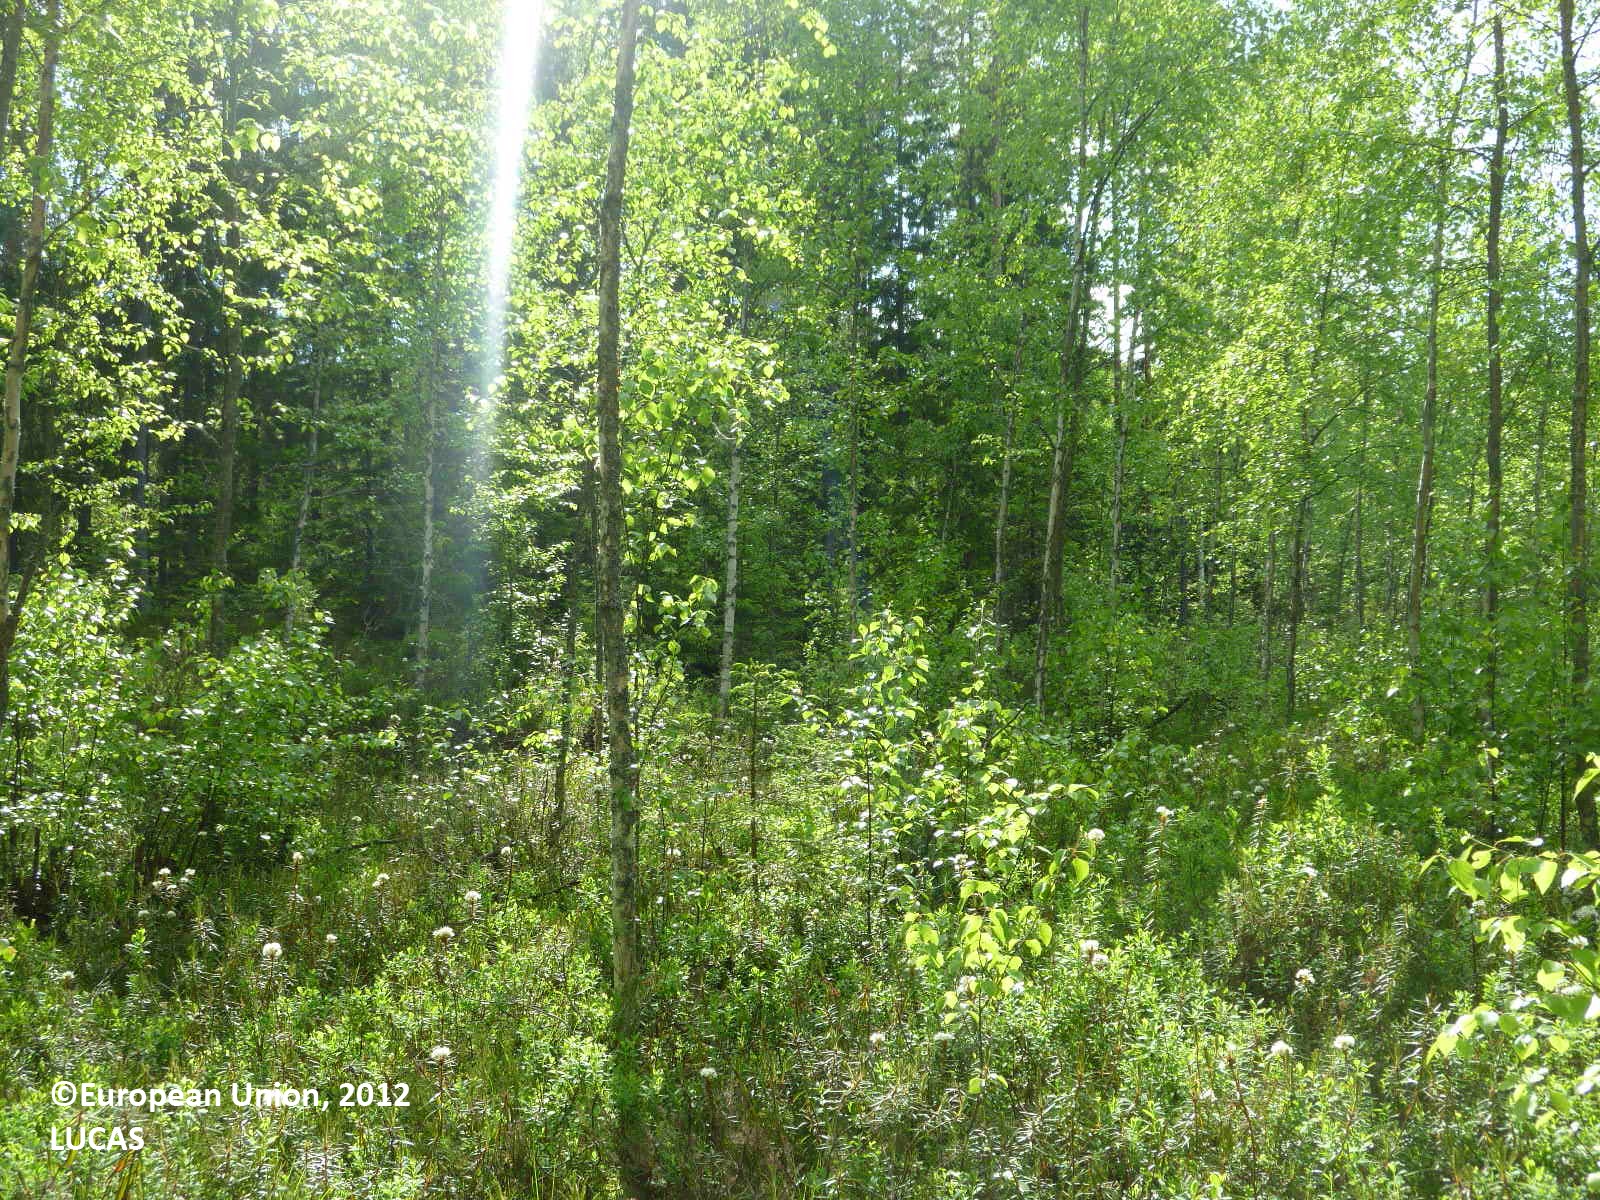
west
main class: Woodland
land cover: Broadleaved woodland
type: boreal forest
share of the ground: > 75 %
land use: Forestry
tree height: > 5 m
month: June
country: FI
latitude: 61.4089
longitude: 22.7494
